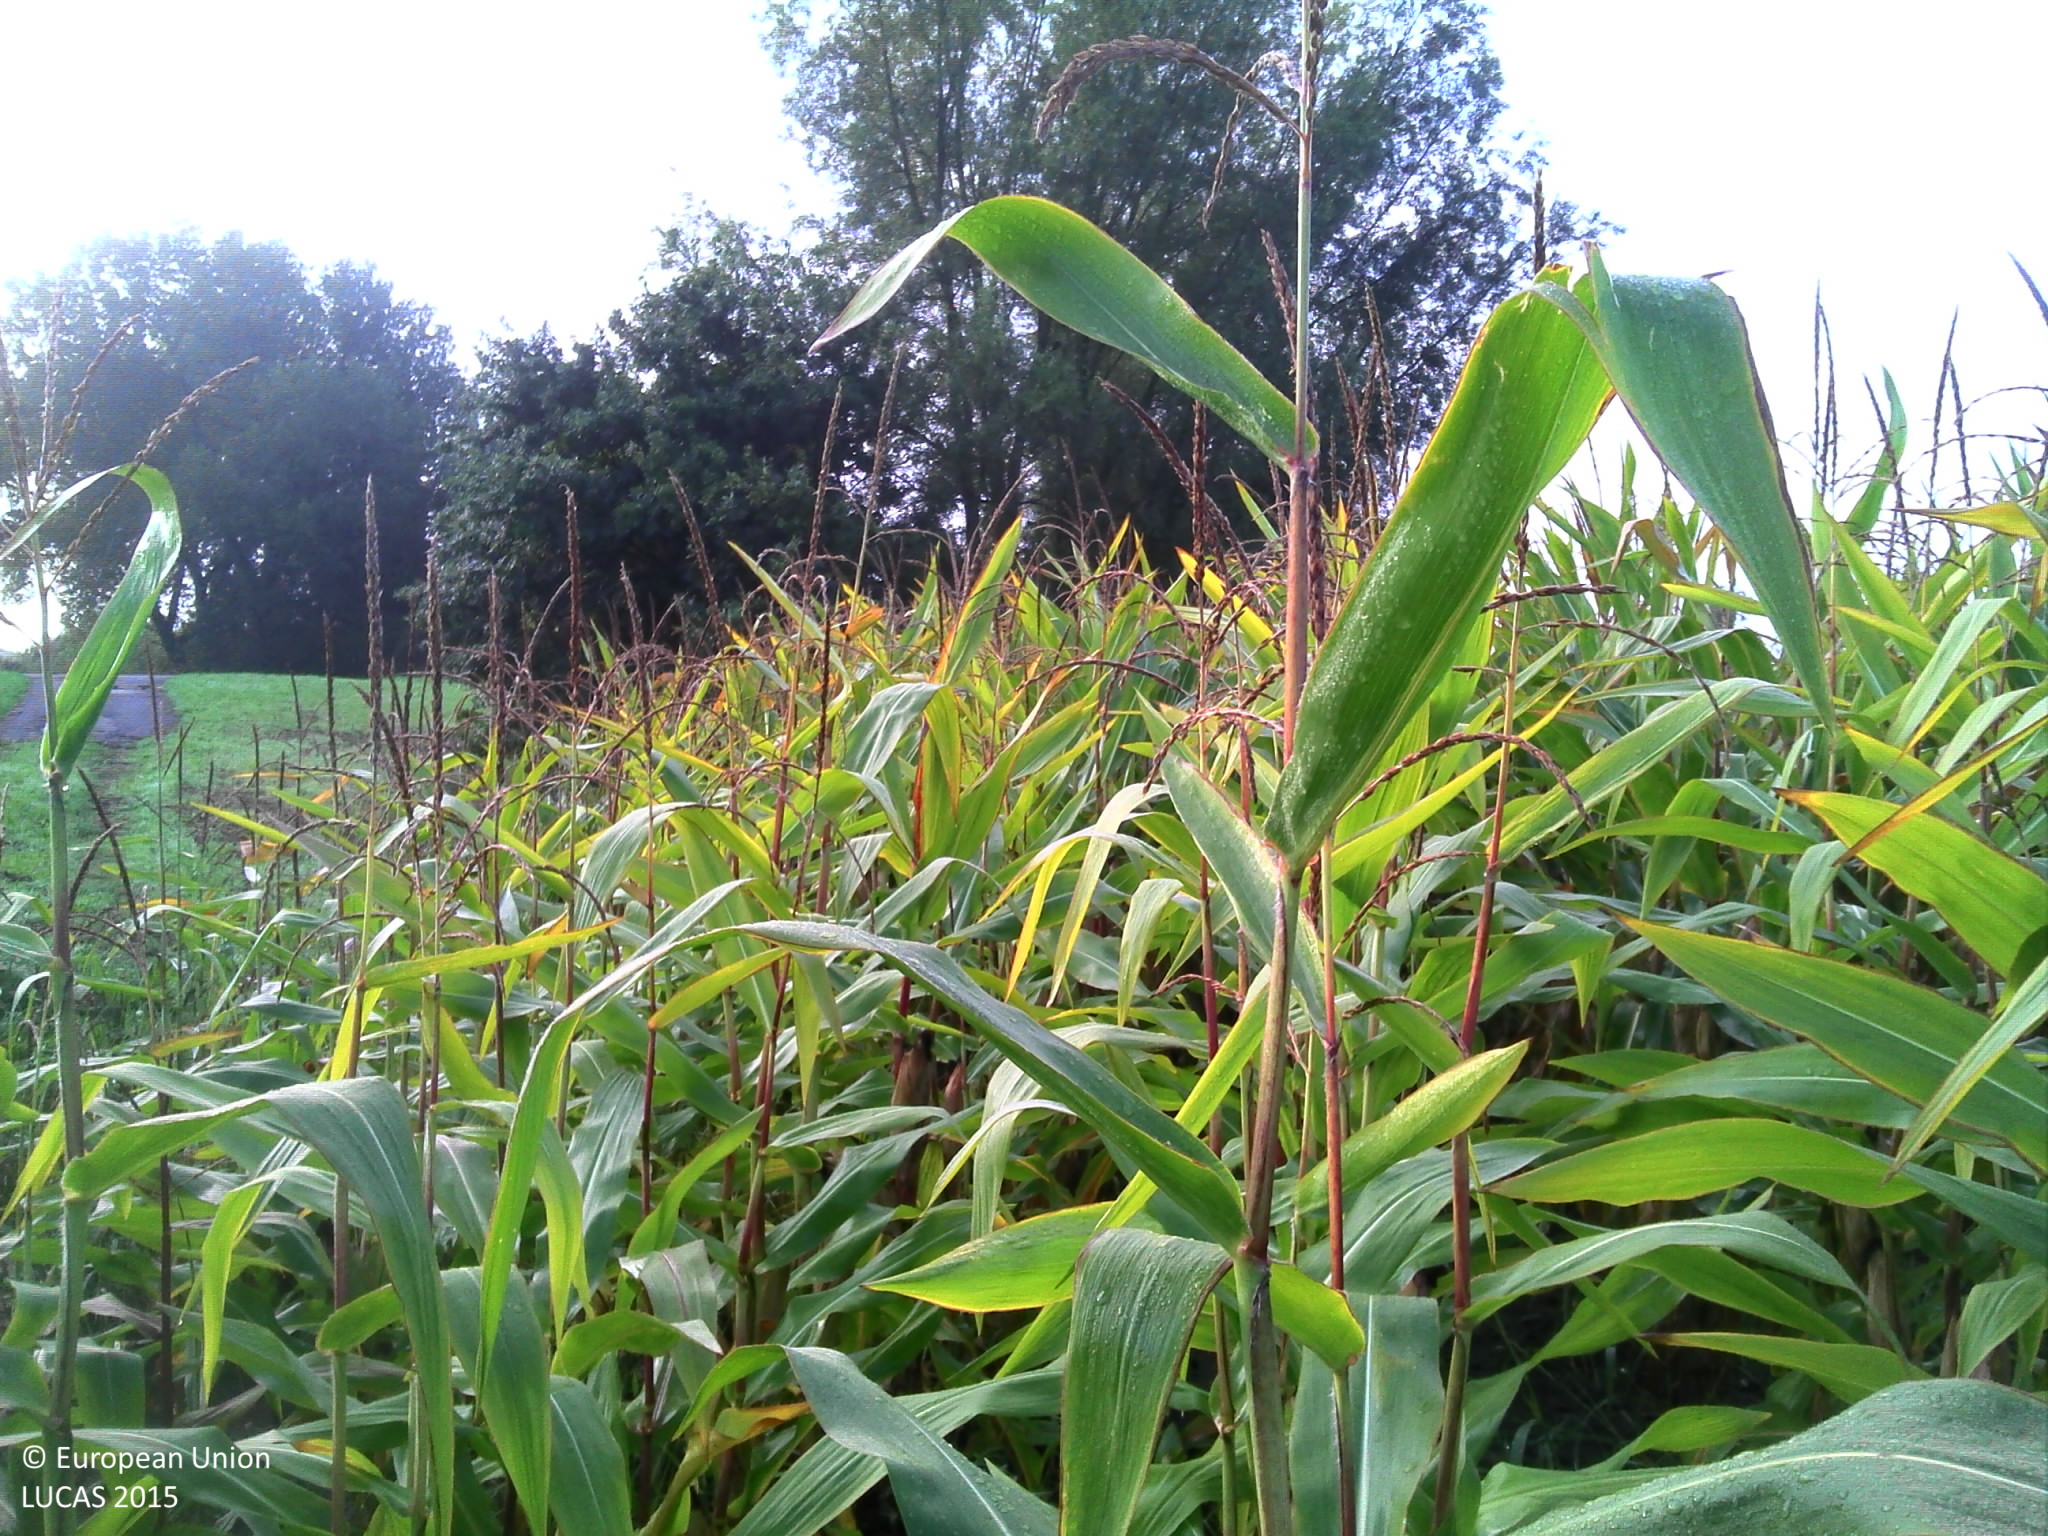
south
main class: Cropland
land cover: Maize
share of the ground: > 75 %
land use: Agriculture (excluding fallow land and kitchen gardens)
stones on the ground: < 10 %
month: September
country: BE
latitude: 51.0747
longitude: 4.4149
